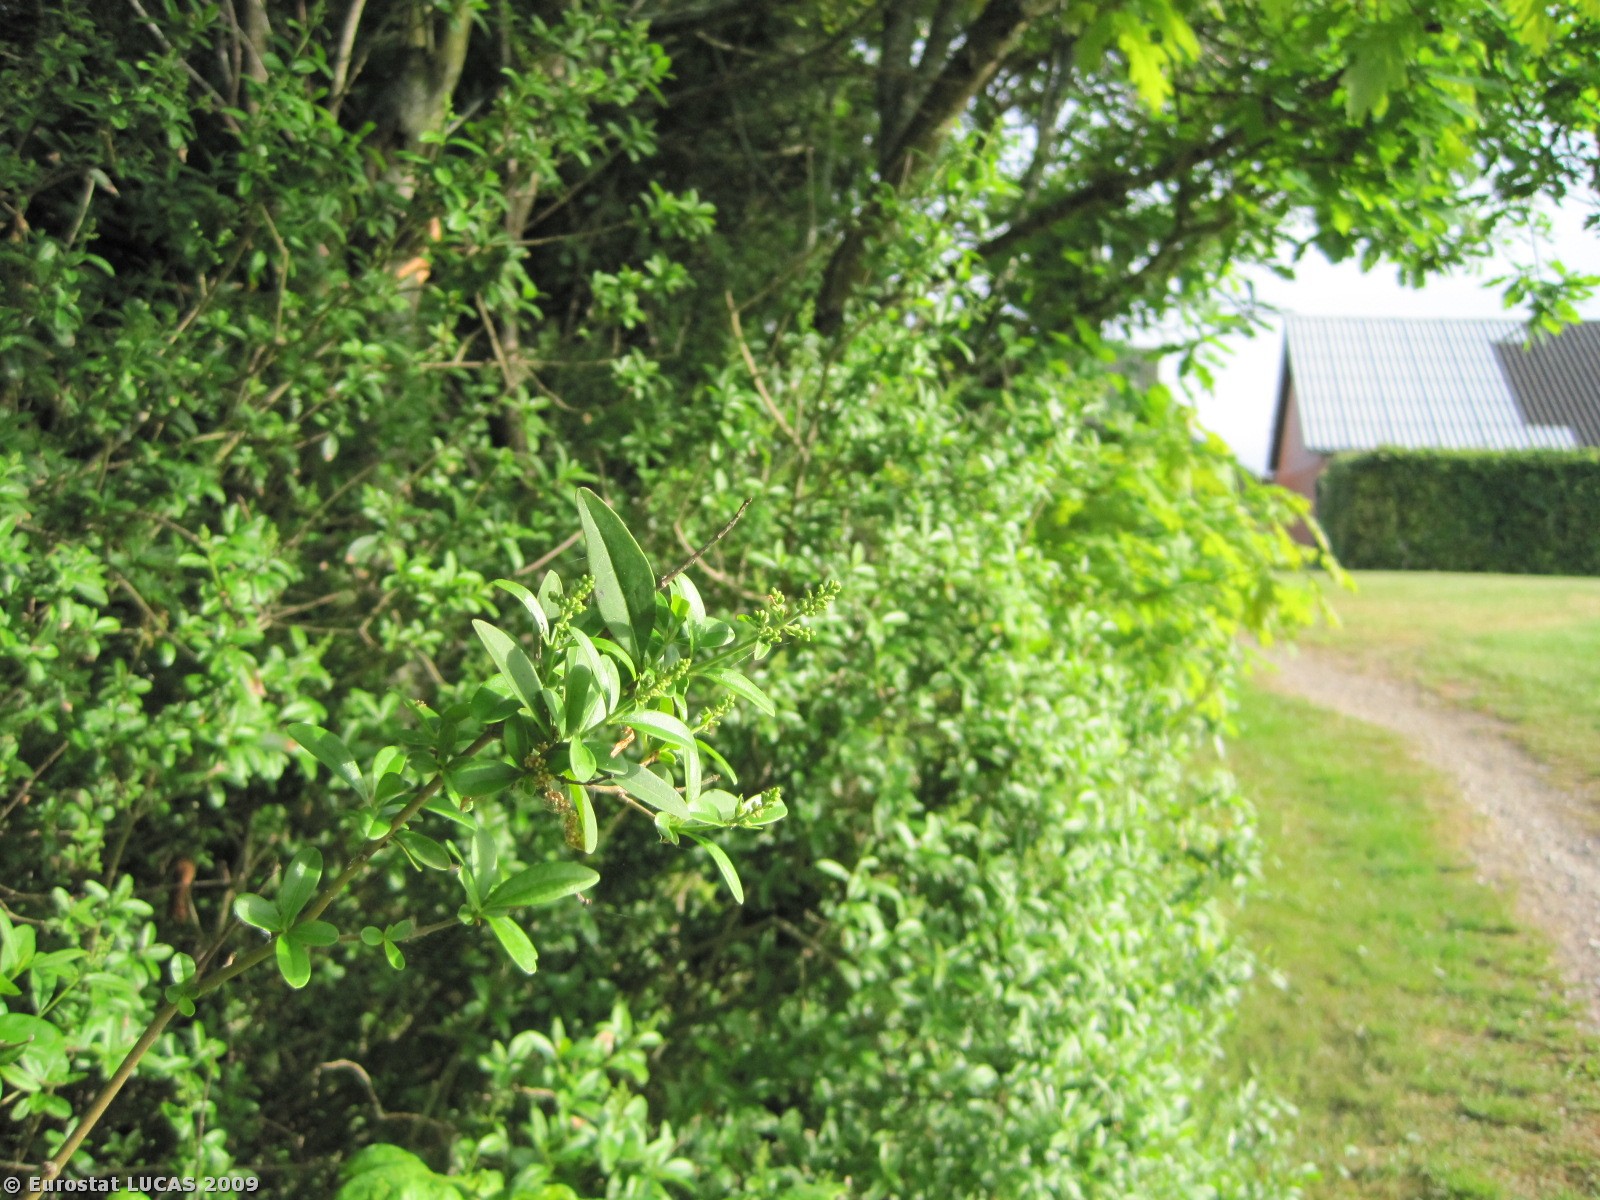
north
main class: Woodland
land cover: Broadleaved woodland
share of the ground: 50 - 75 %
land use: Amenities, museums, leisure
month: June
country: DK
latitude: 57.1046
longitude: 10.0824
